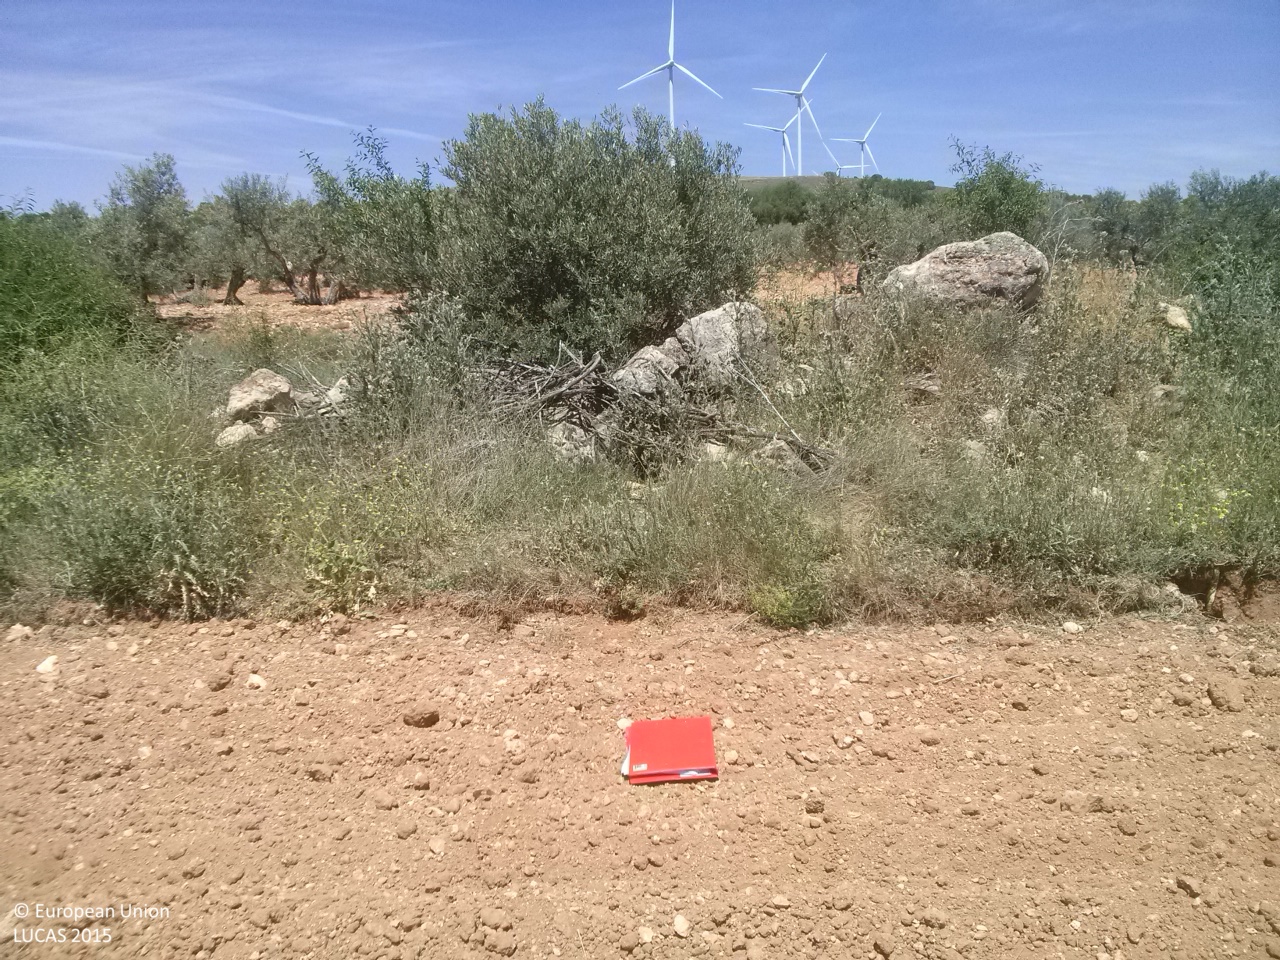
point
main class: Cropland
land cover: Sunflower
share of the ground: < 10 %
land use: Agriculture (excluding fallow land and kitchen gardens)
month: May
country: ES
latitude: 39.9806
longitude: -2.7494
